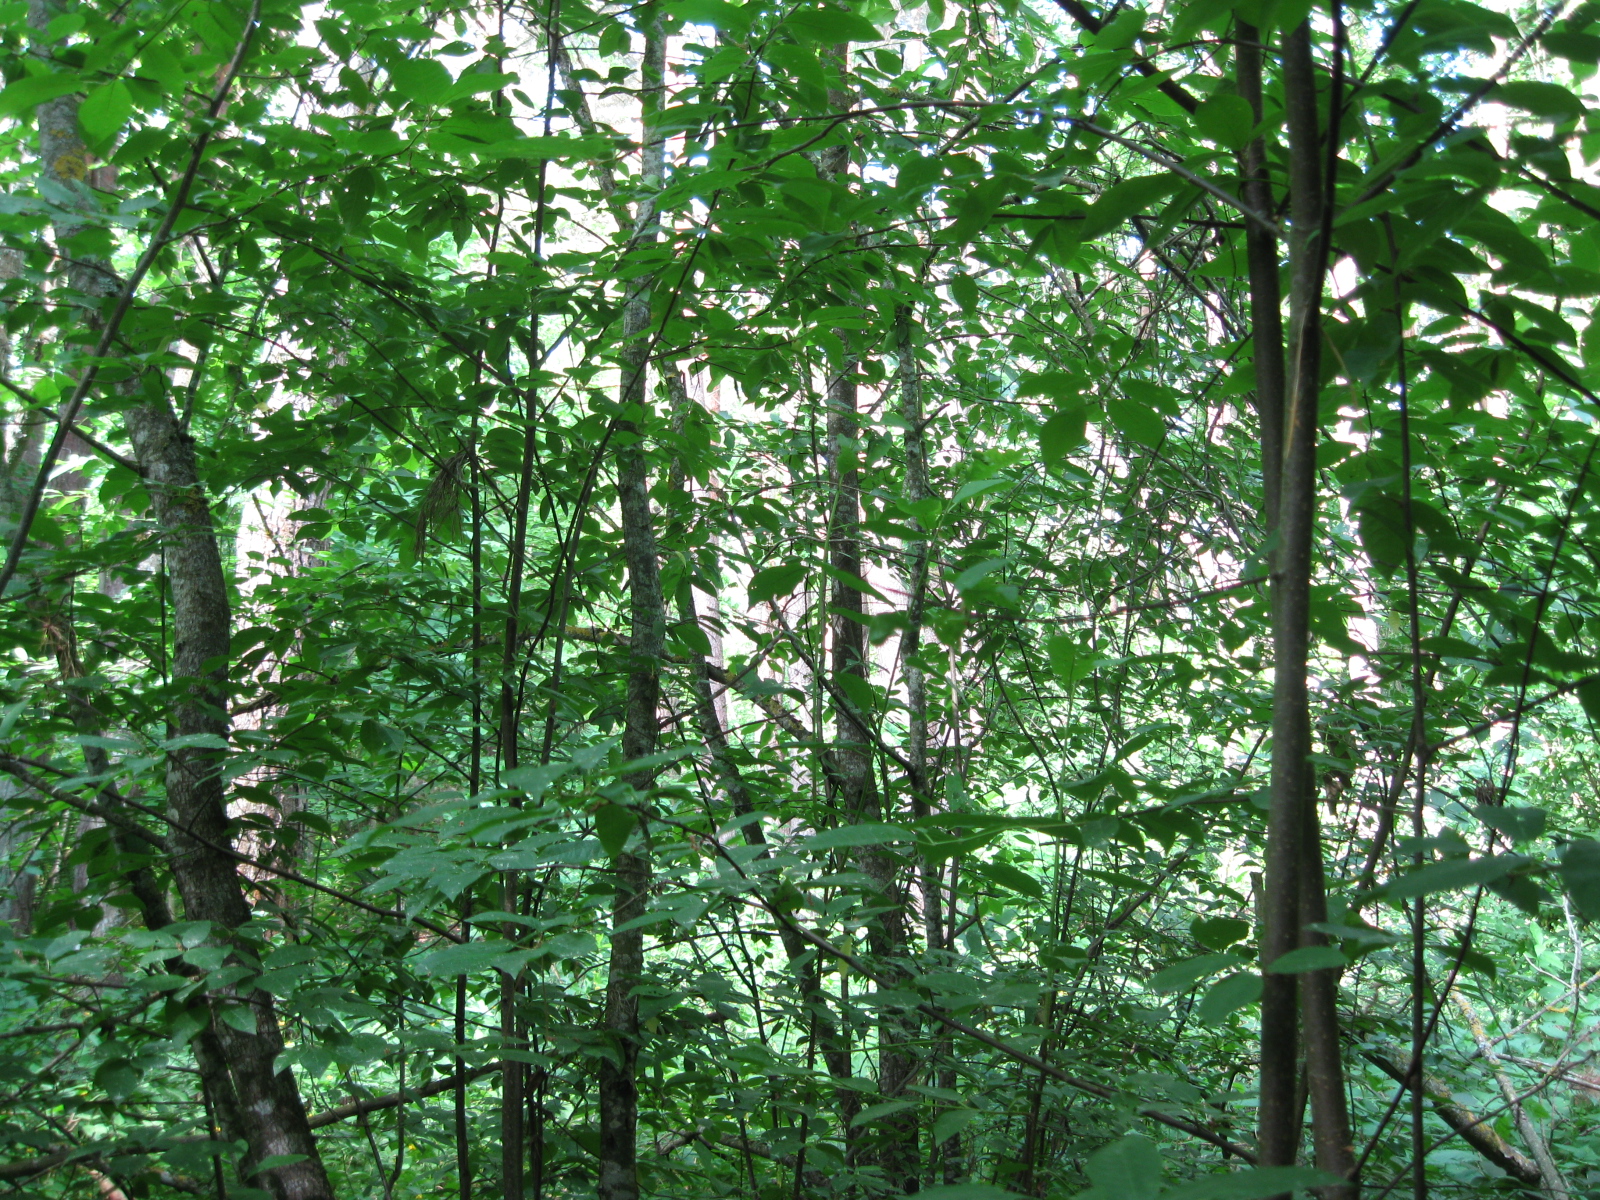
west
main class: Woodland
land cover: Pine dominated mixed woodland
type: hemiboreal forest and nemoral coniferous forest and mixed broadleaved-coniferous forest
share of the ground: > 75 %
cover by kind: broadleaved forest trees 45 %, coniferous forest trees 40 %, herbaceous plants 10 %, shrubs 5 %
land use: Forestry
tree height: > 5 m
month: June
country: LT
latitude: 55.7443
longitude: 23.8320
